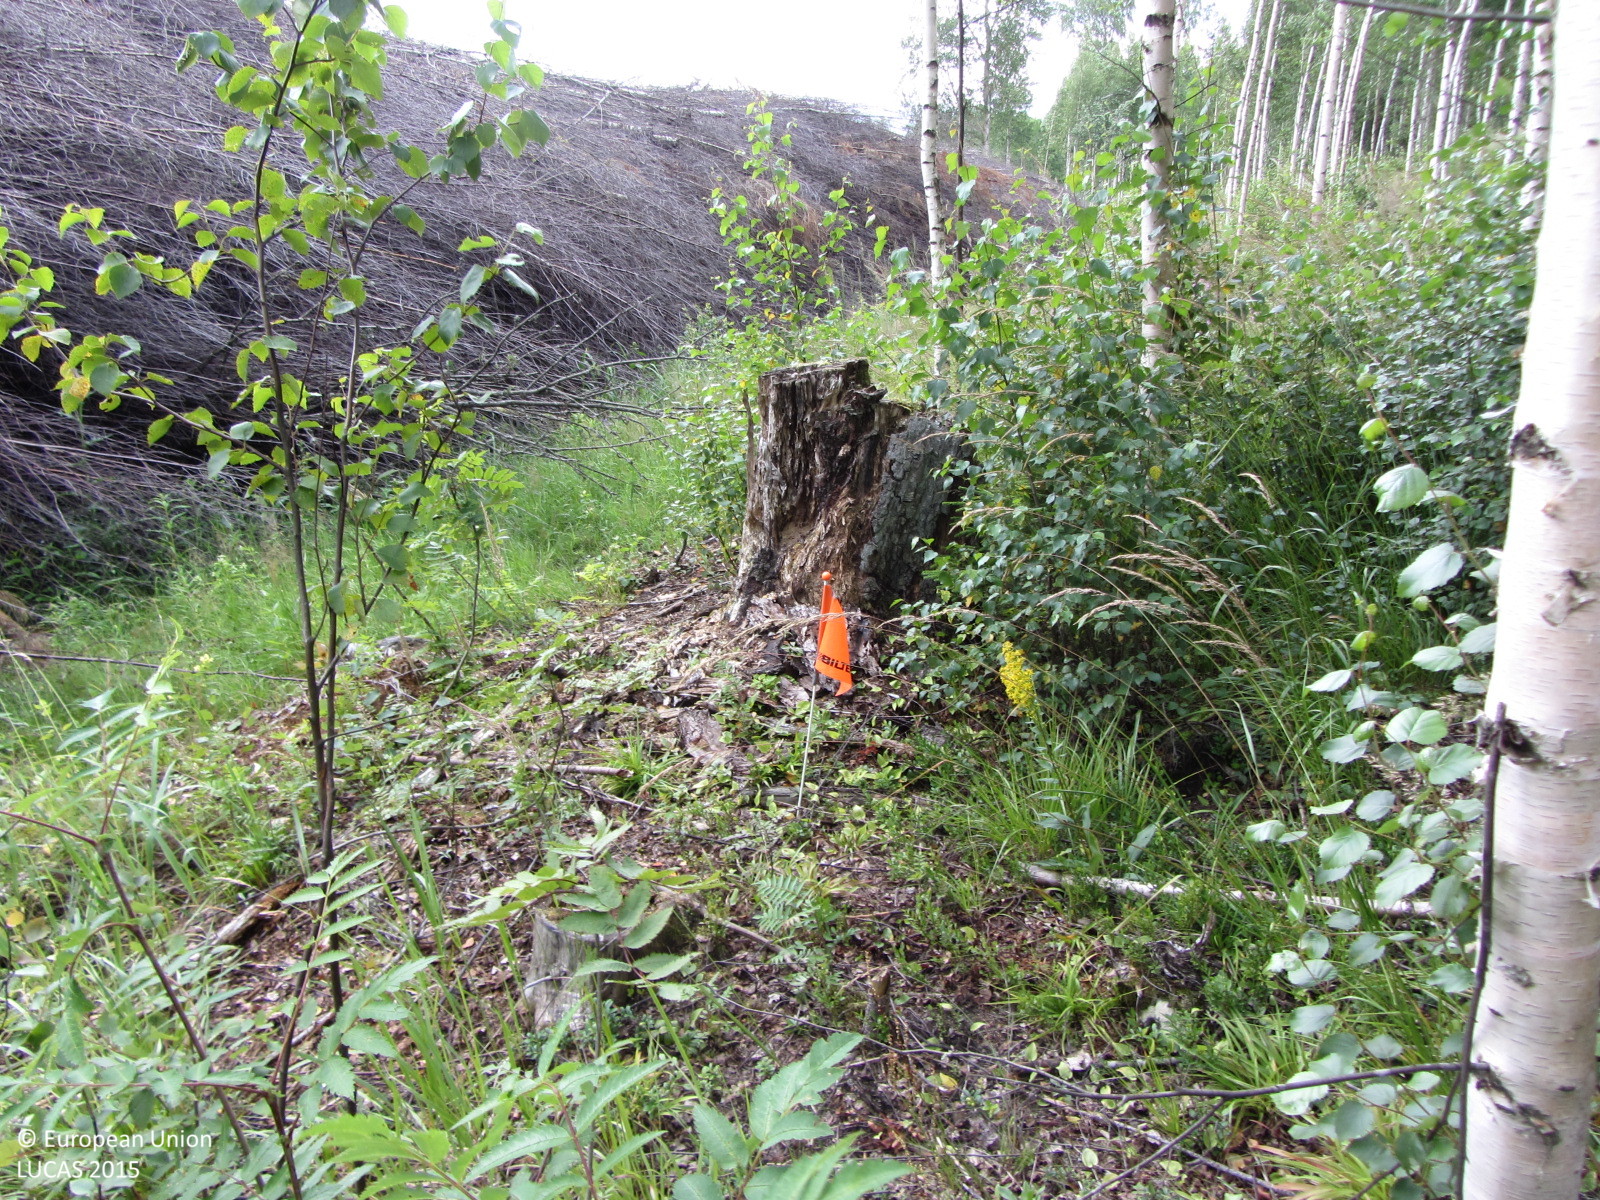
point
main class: Woodland
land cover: Broadleaved woodland
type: boreal forest
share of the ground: 25 - 50 %
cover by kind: herbaceous plants 55 %, broadleaved forest trees 45 %
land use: Forestry
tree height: > 5 m
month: July
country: FI
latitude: 60.5368
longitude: 24.9335
